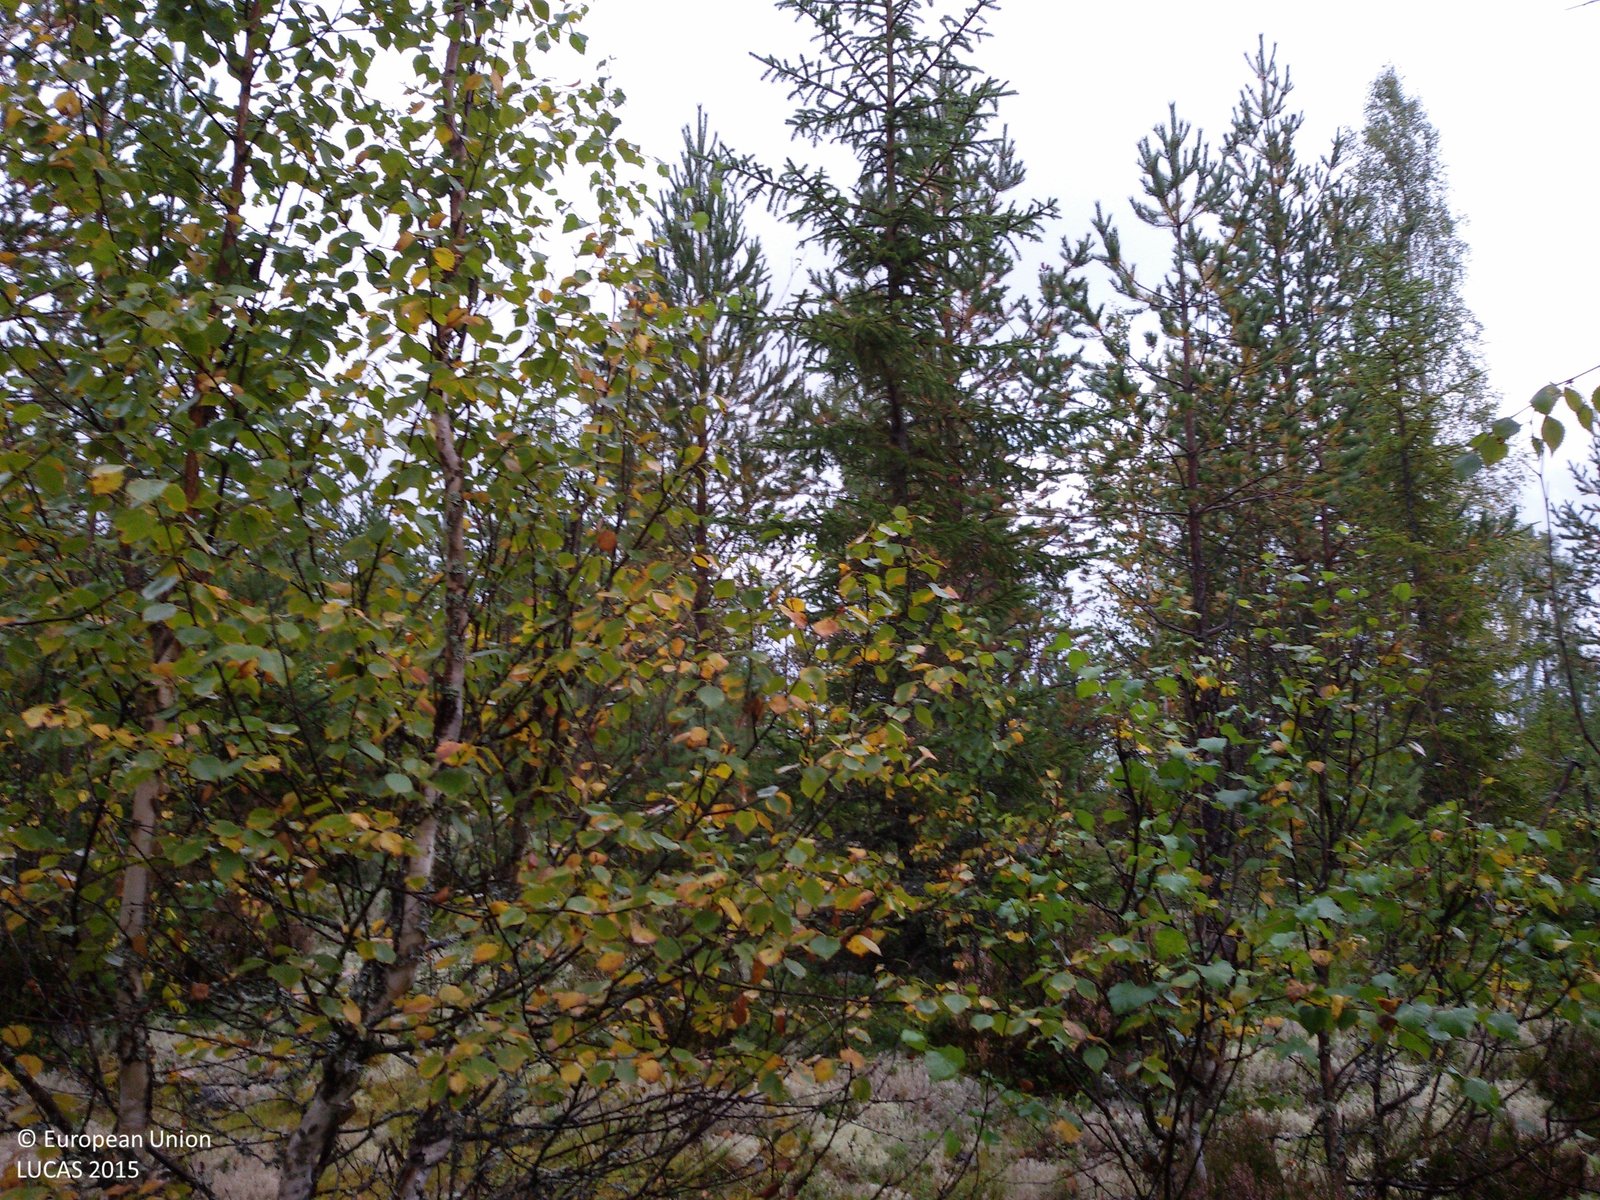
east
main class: Woodland
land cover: Pine dominated mixed woodland
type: boreal forest
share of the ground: 50 - 75 %
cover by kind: coniferous forest trees 40 %, broadleaved forest trees 30 %, lichens and mosses 20 %, herbaceous plants 10 %
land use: Forestry
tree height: > 5 m
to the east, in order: Pine dominated mixed woodland; Pine dominated coniferous woodland
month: September
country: SE
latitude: 60.8732
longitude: 14.2787
